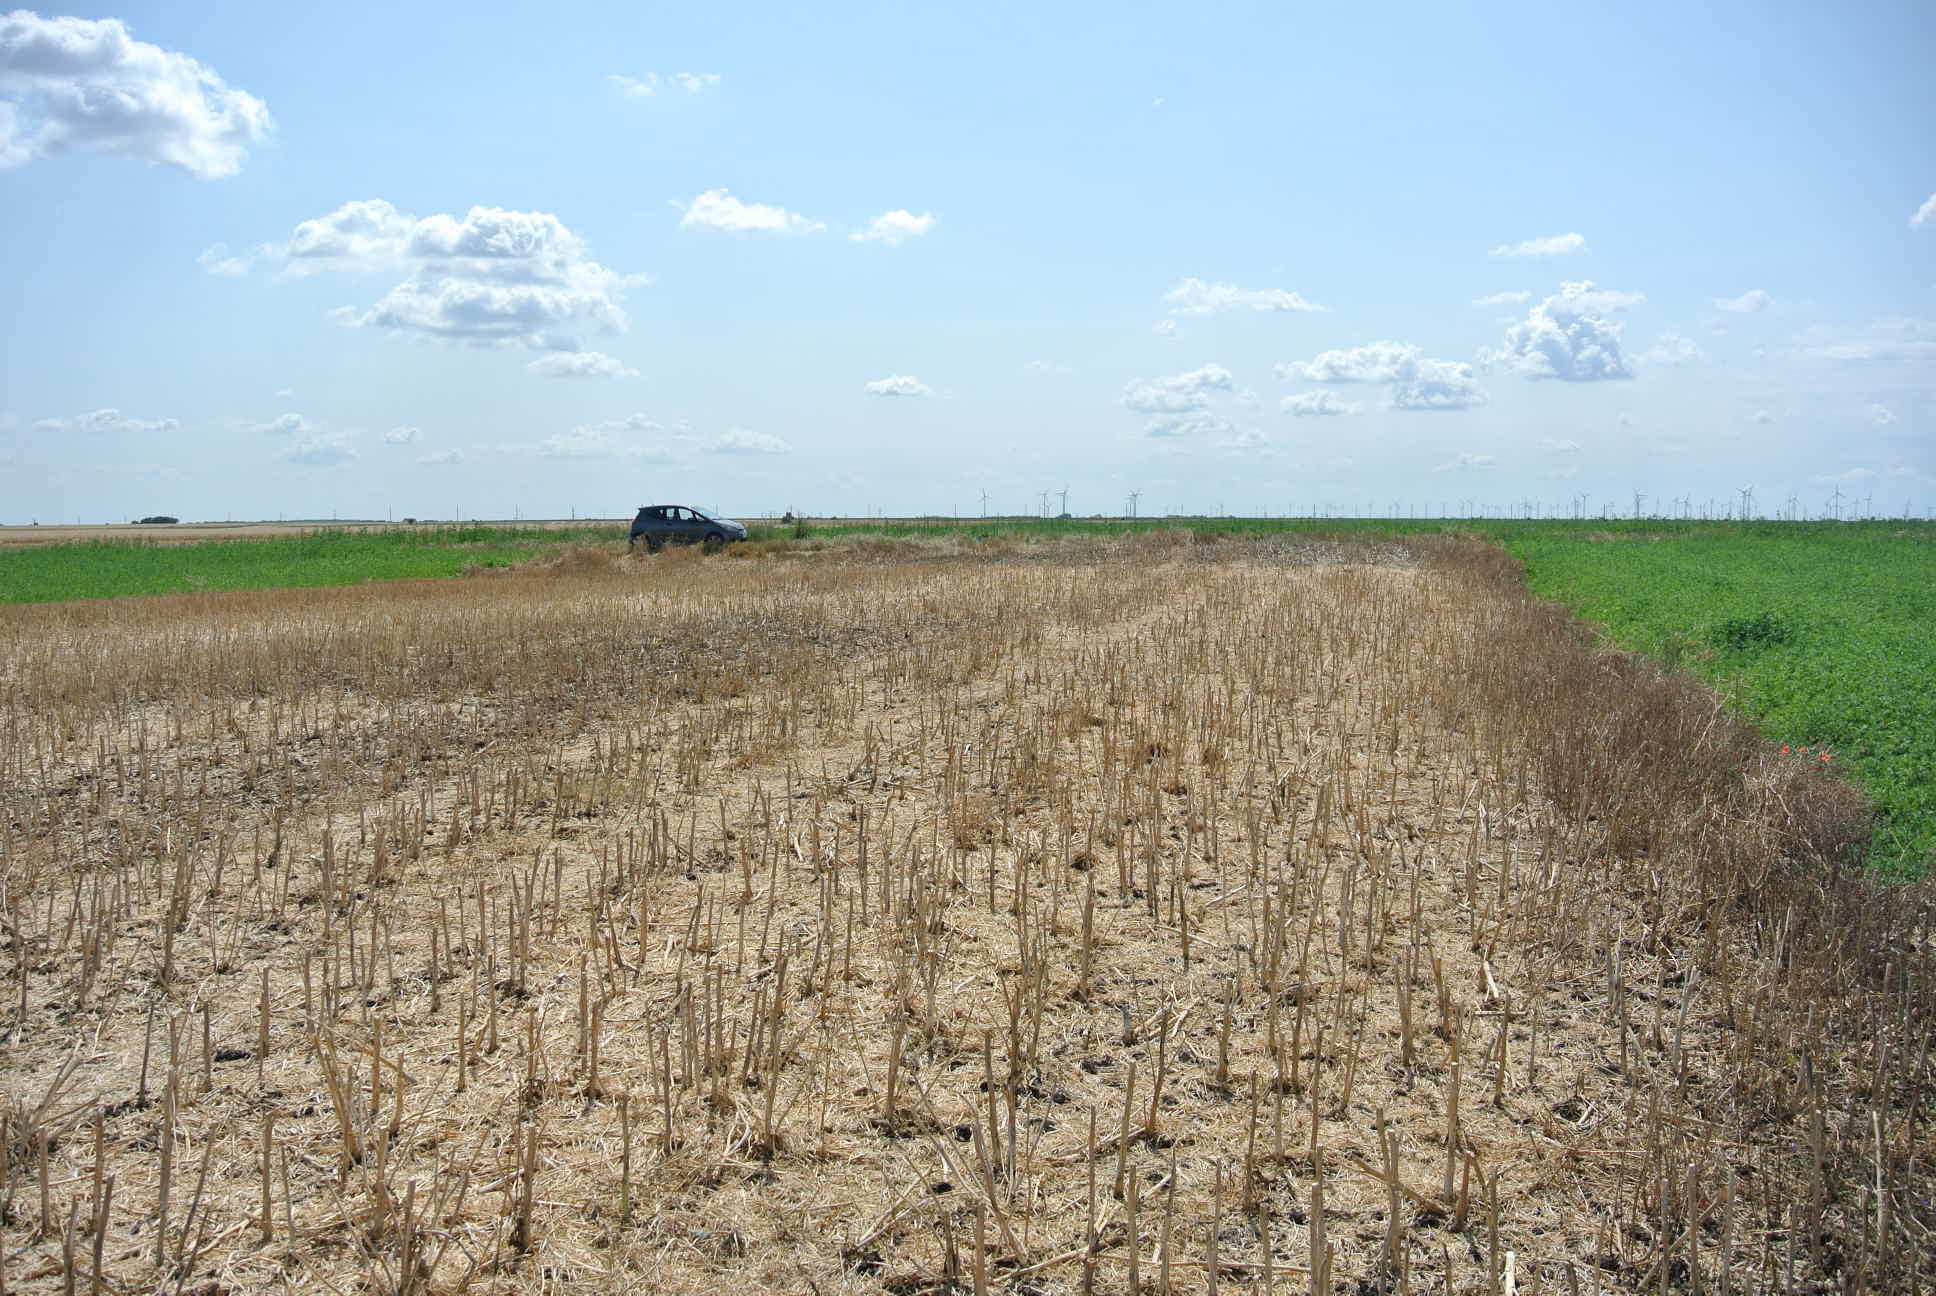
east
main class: Cropland
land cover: Rape and turnip rape
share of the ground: > 75 %
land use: Agriculture (excluding fallow land and kitchen gardens)
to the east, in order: Rape and turnip rape; Other fibre and oleaginous crops; Grass margins; Paved roads, cycling and walking lanes; Grass margins; Other fibre and oleaginous crops; Rape and turnip rape; Grass margins; Paved roads, cycling and walking lanes; Other bare soil; Common wheat
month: July
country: AT
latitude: 48.0067
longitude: 16.9099
